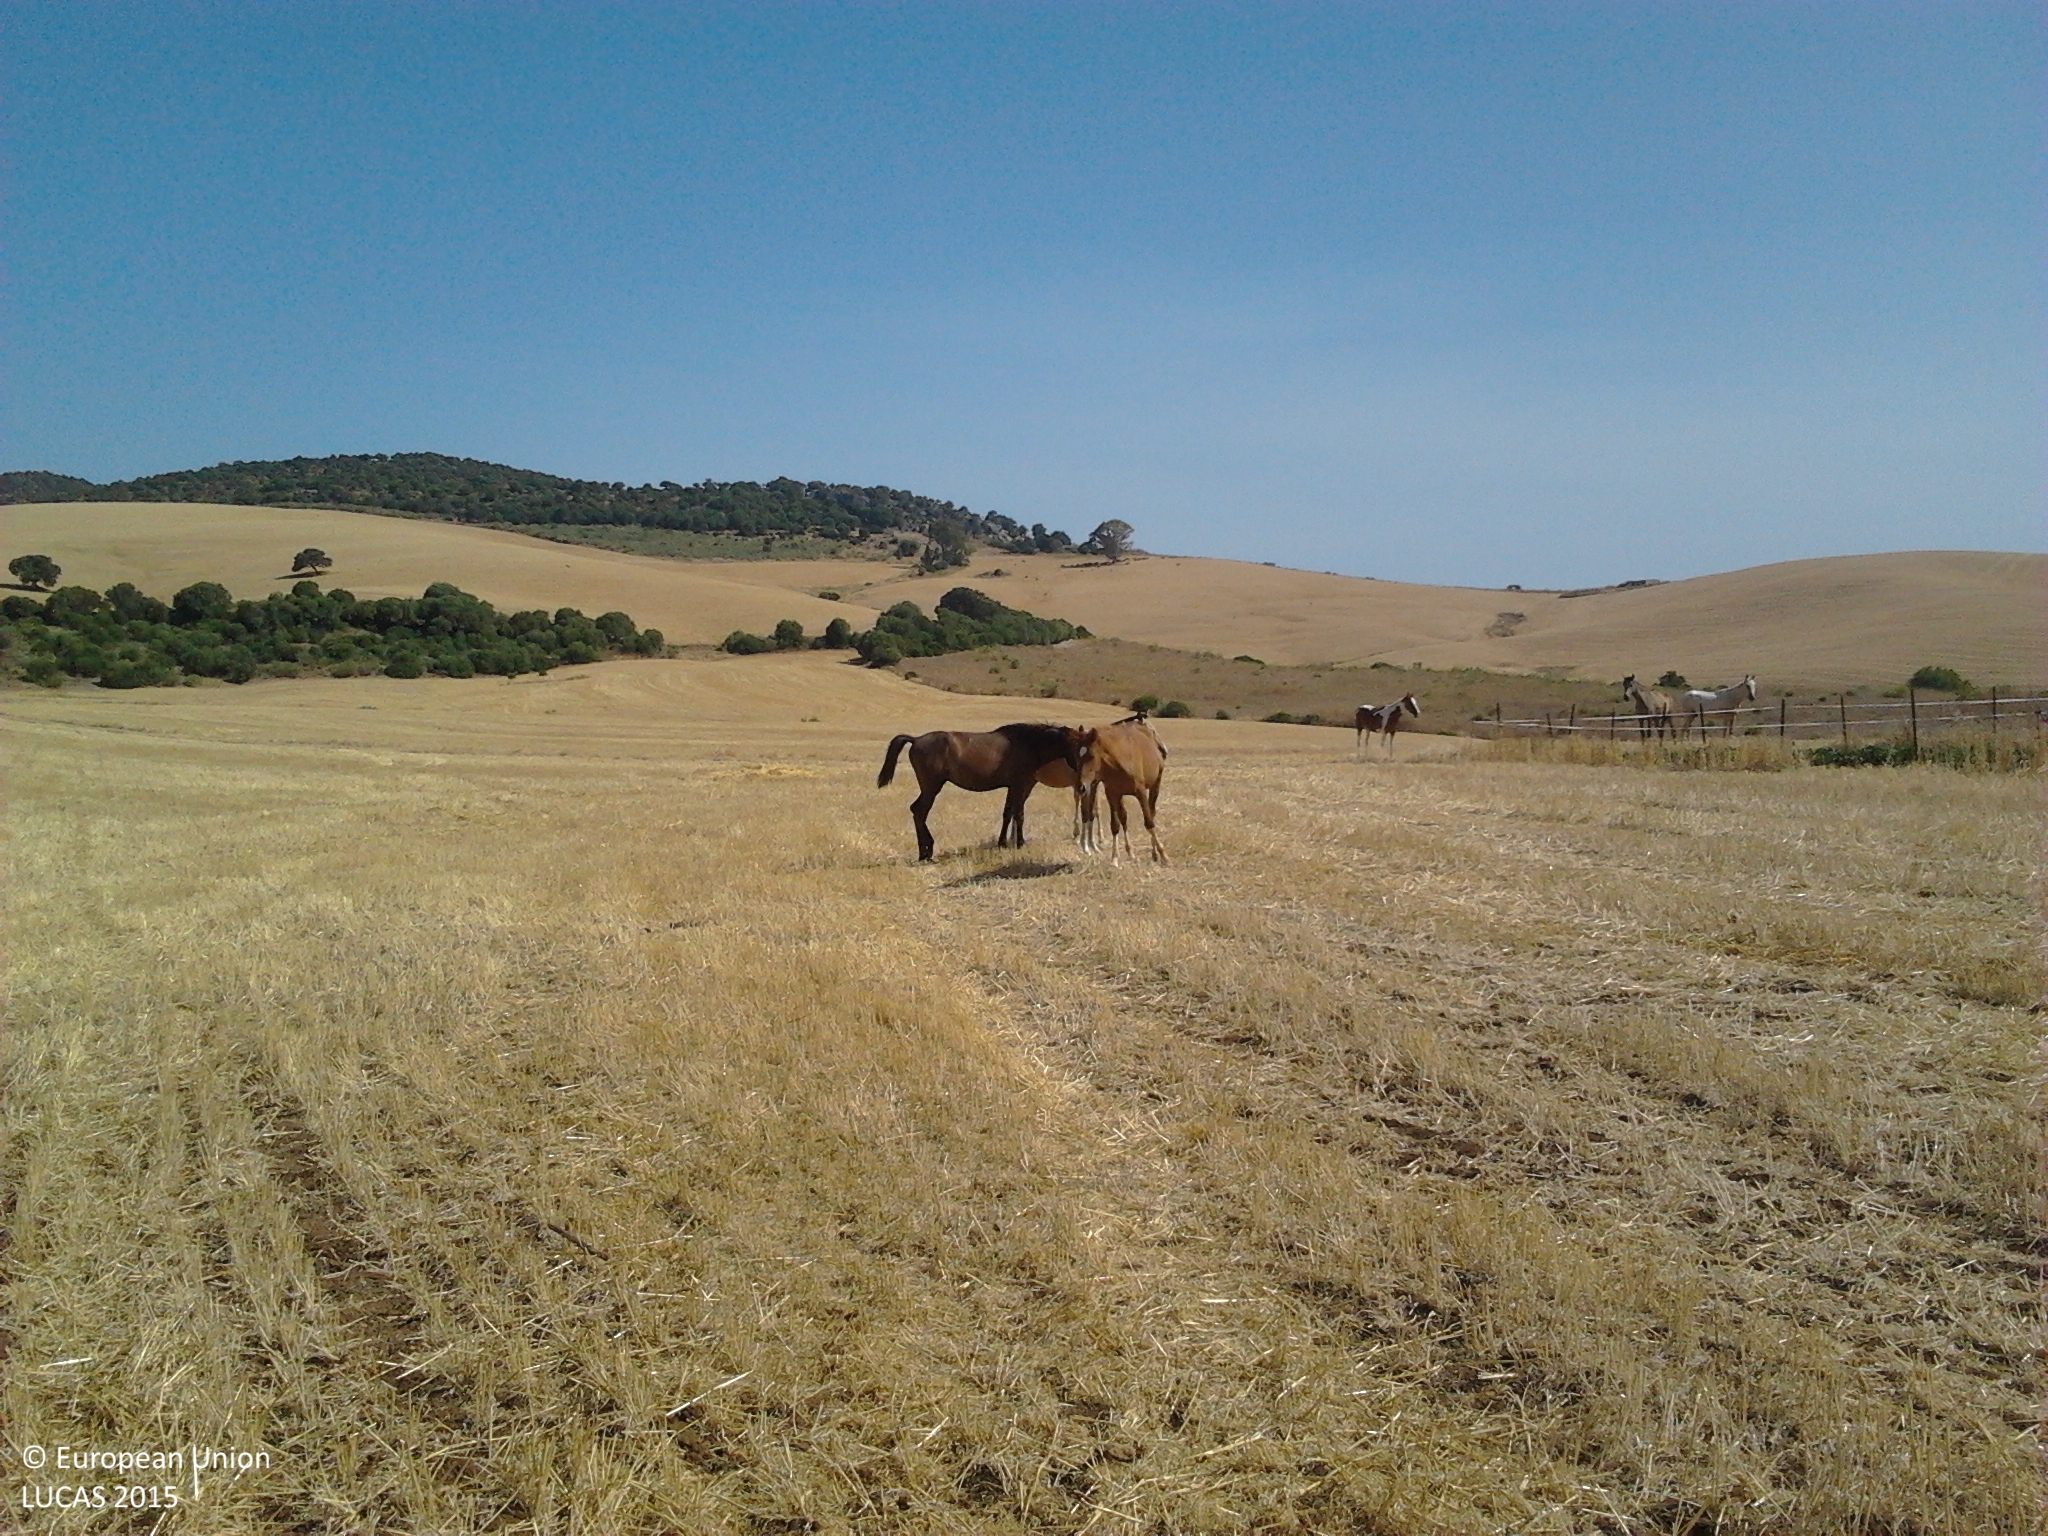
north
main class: Cropland
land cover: Common wheat
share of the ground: < 10 %
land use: Agriculture (excluding fallow land and kitchen gardens)
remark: Harvested field
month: July
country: ES
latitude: 36.6773
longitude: -5.6822
